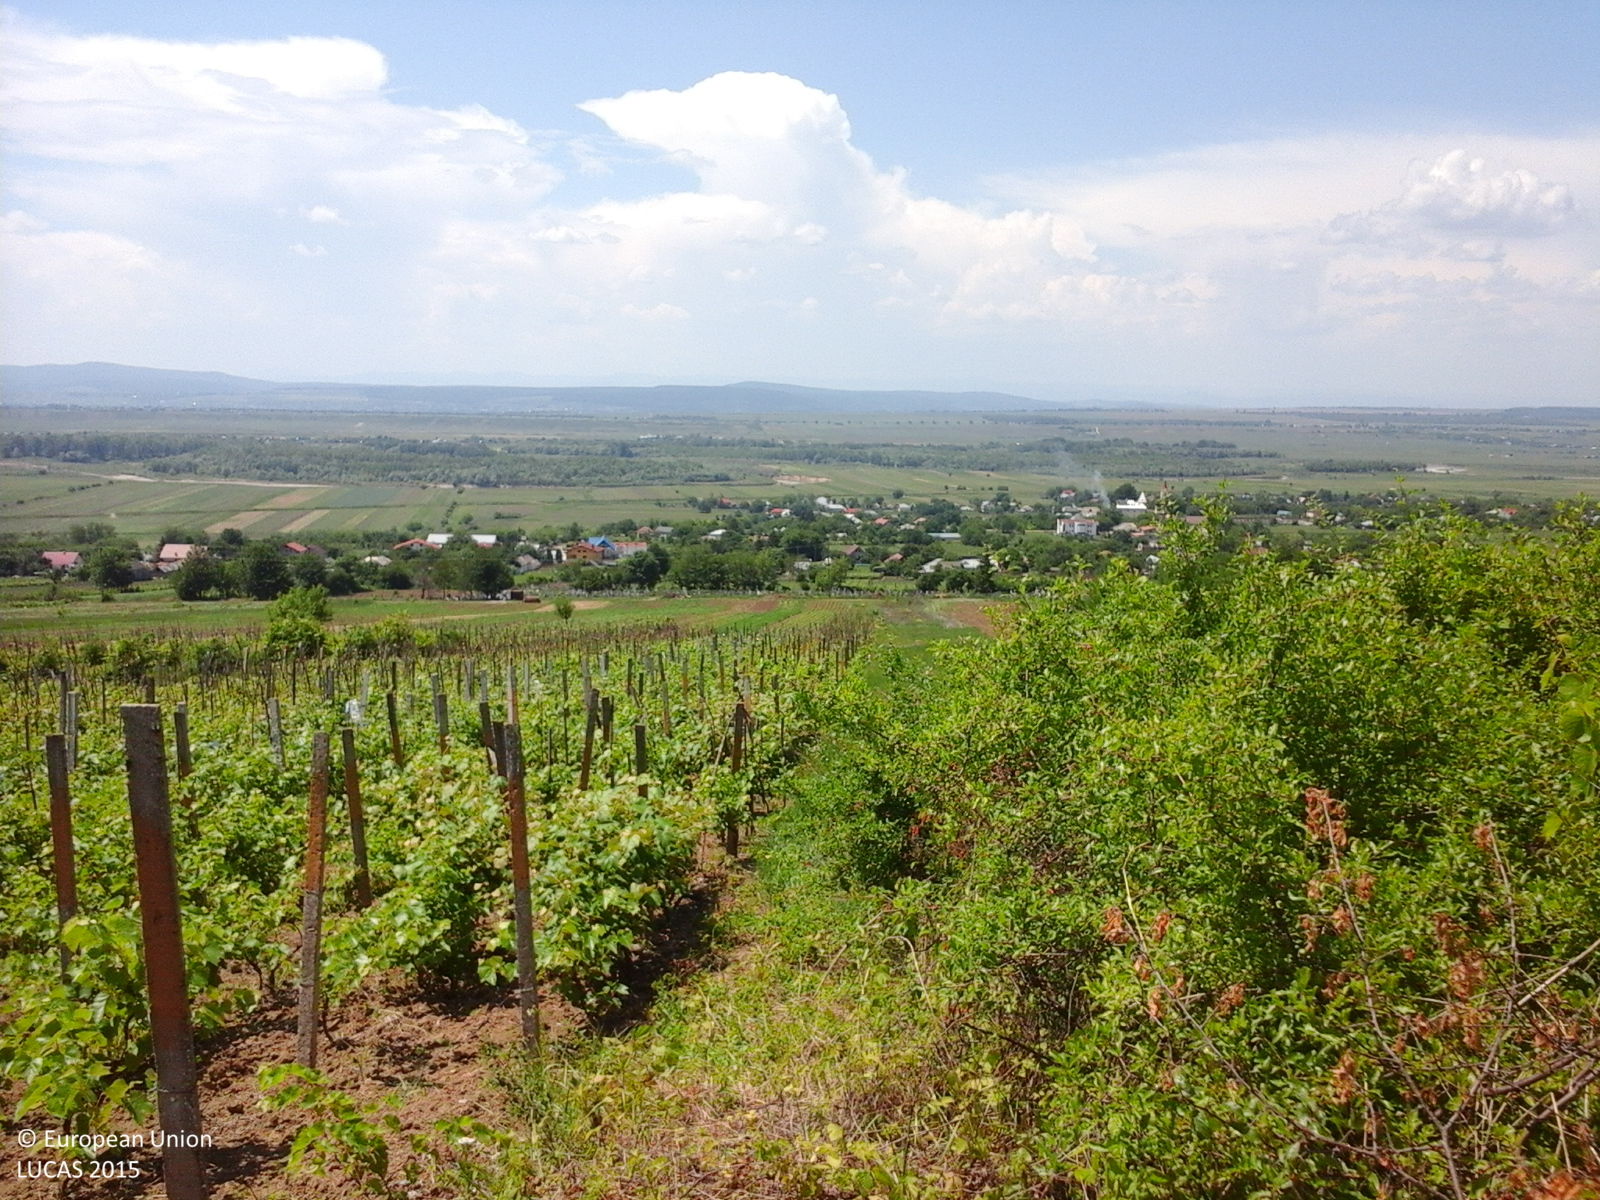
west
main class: Shrubland
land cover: Shrubland without tree cover
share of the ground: > 75 %
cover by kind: shrubs 100 %
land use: Semi-natural and natural areas not in use
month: June
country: RO
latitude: 46.6523
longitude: 26.9921
